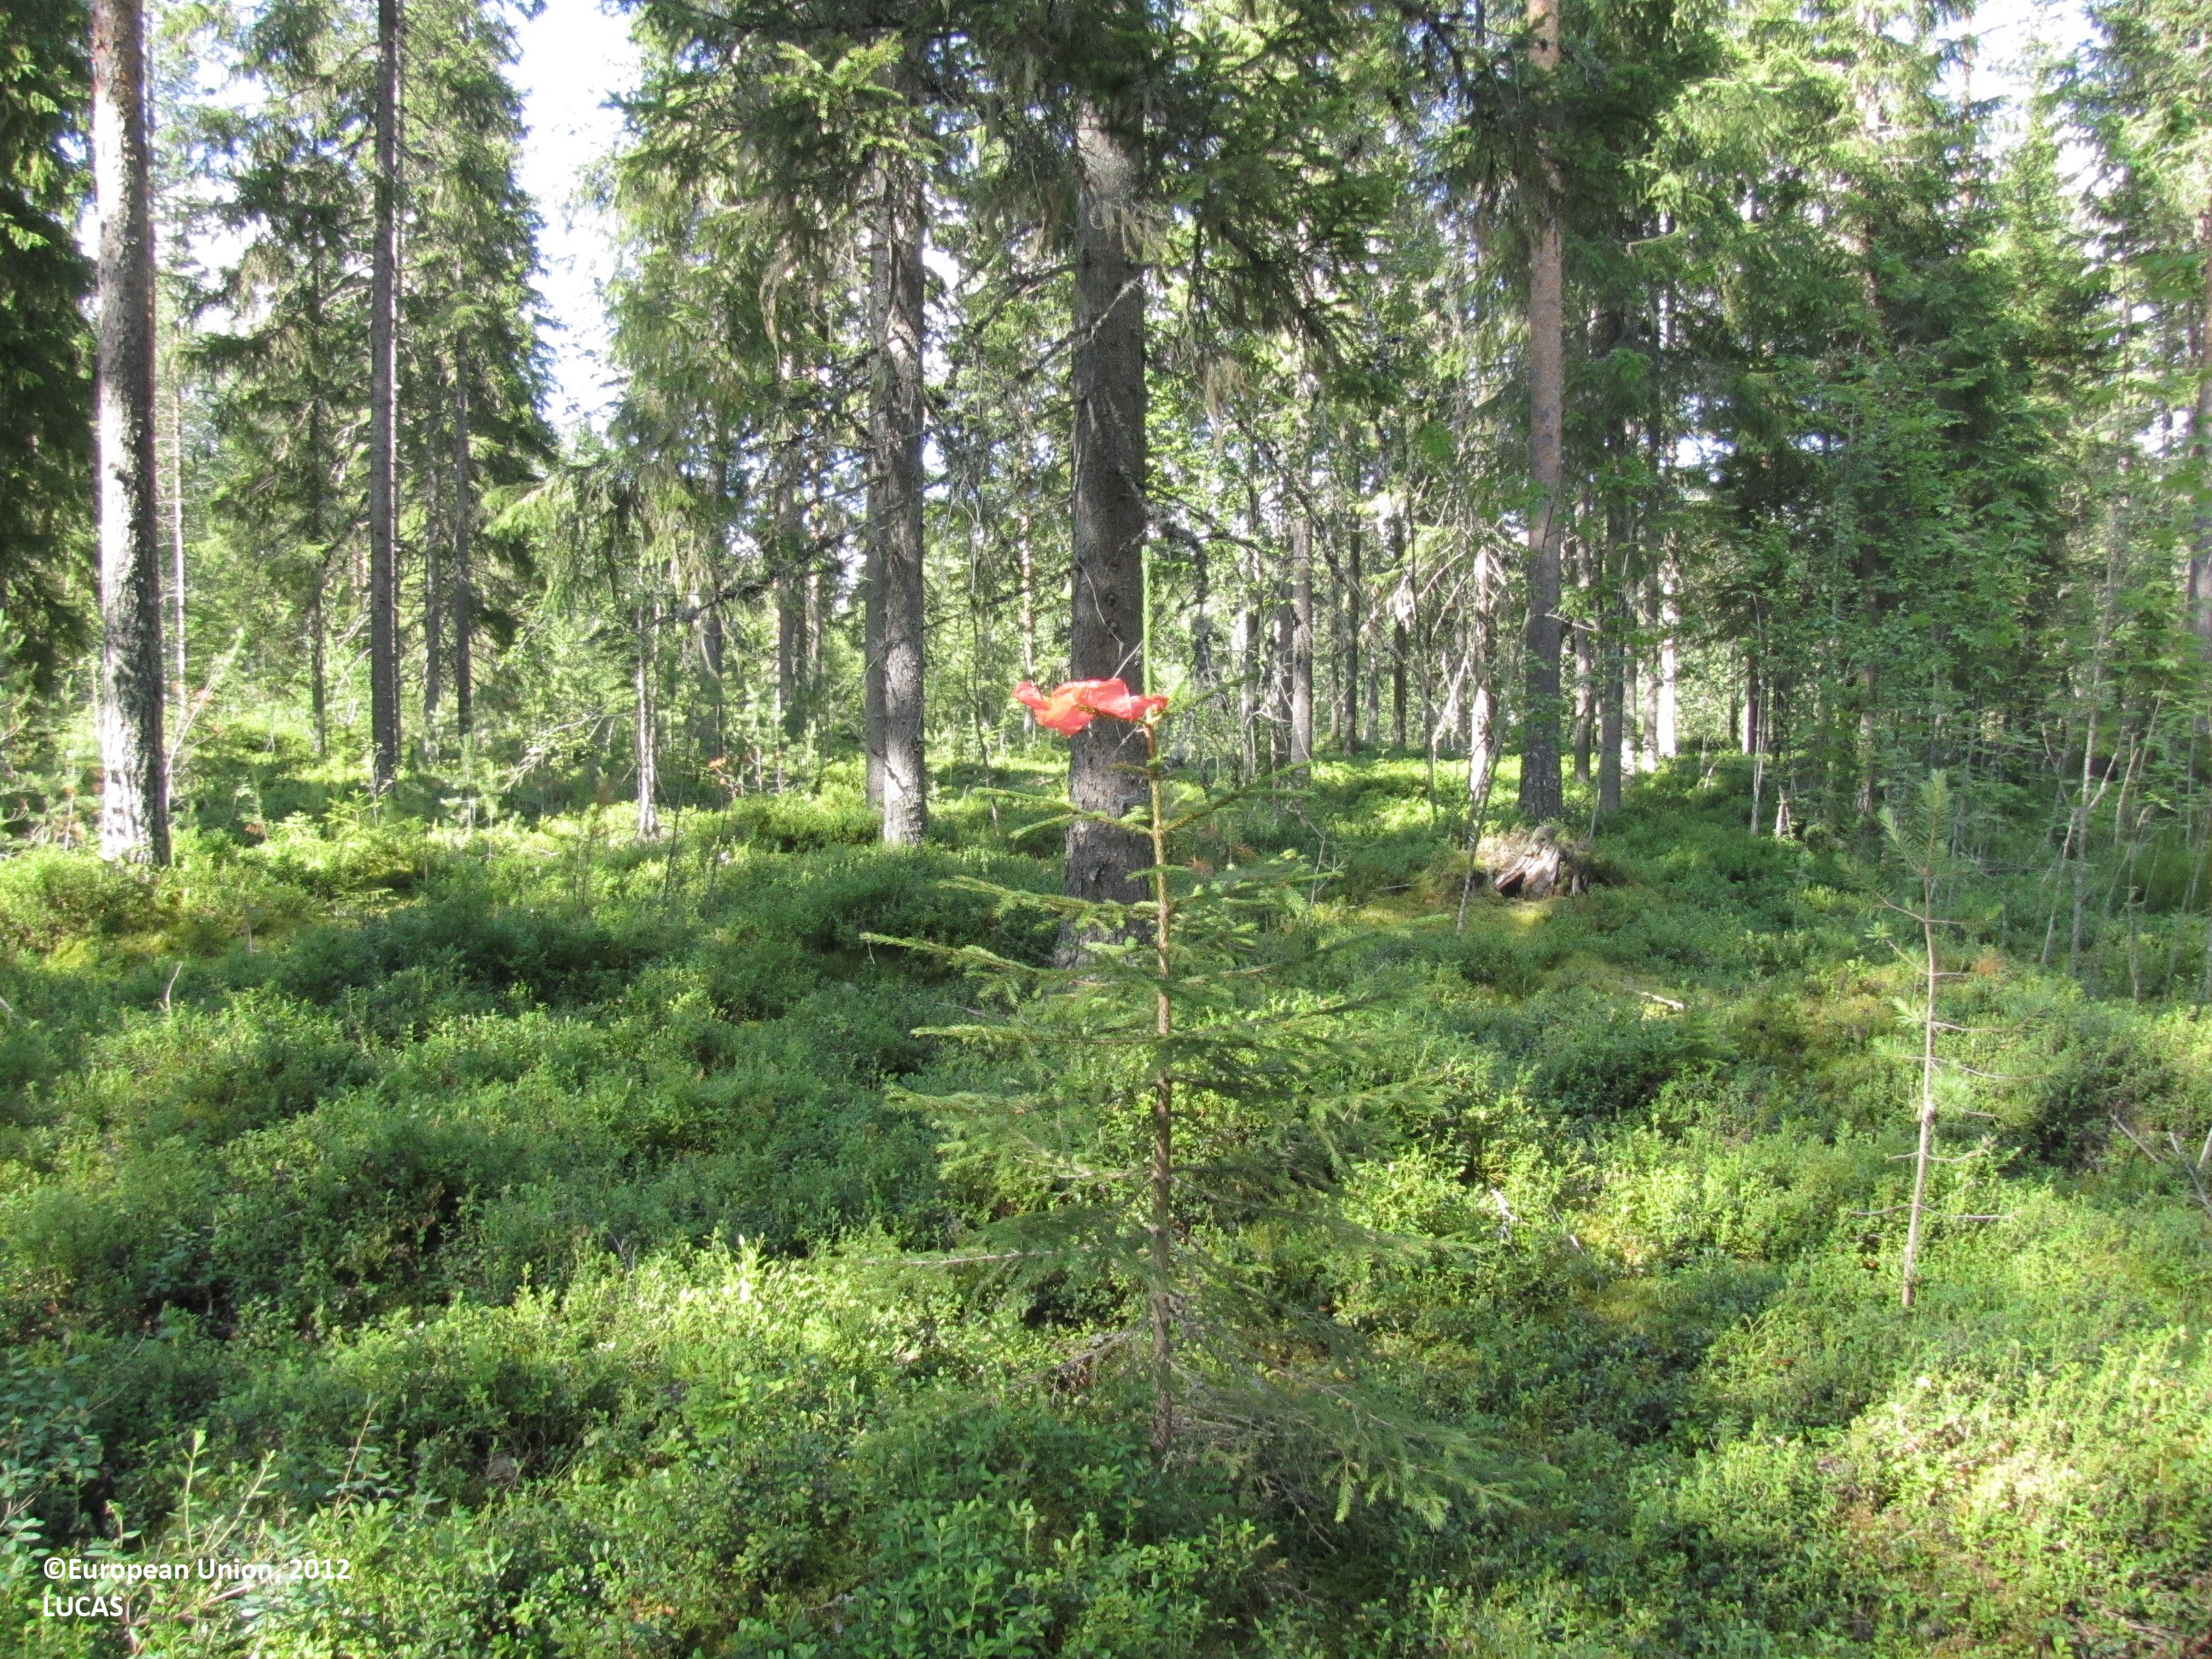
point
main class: Woodland
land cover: Spruce dominated coniferous woodland
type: boreal forest
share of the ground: 50 - 75 %
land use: Forestry
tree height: > 5 m
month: July
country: FI
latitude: 62.1868
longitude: 23.2682
